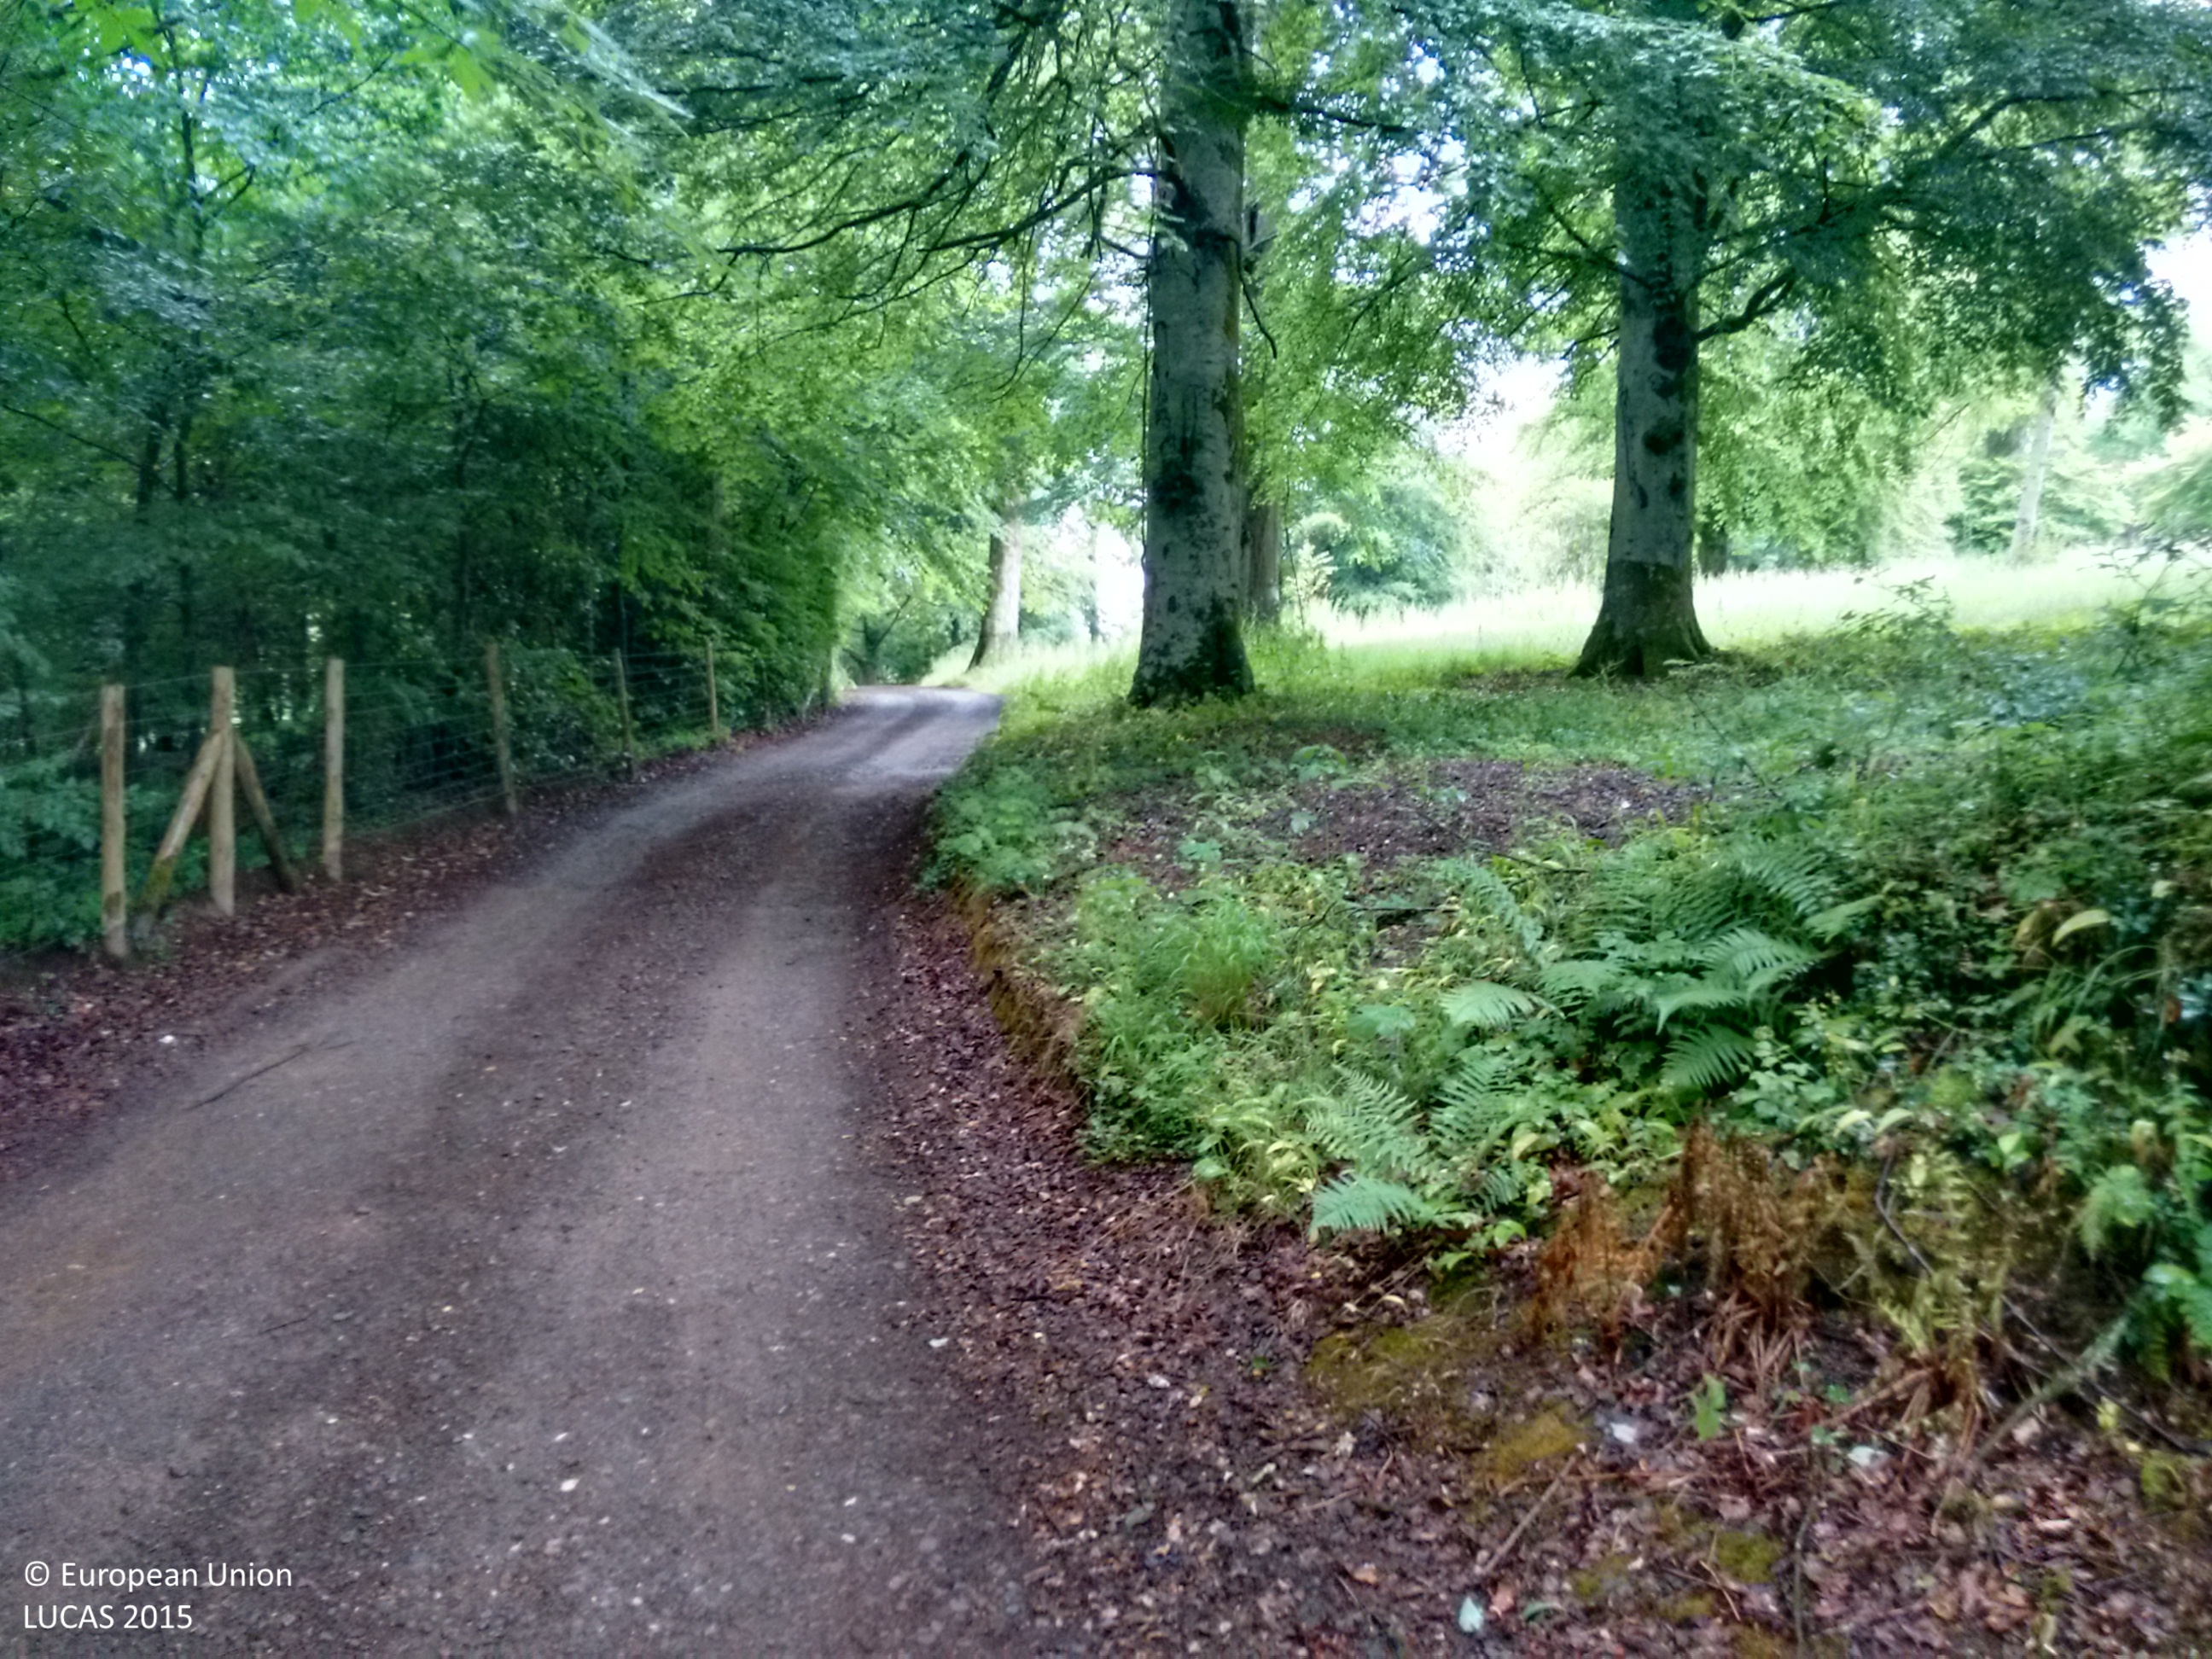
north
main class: Woodland
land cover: Broadleaved woodland
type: mesophytic deciduous forest
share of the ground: > 75 %
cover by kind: broadleaved forest trees 100 %
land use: Residential
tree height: > 5 m
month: July
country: GB
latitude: 51.0325
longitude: -3.5317
